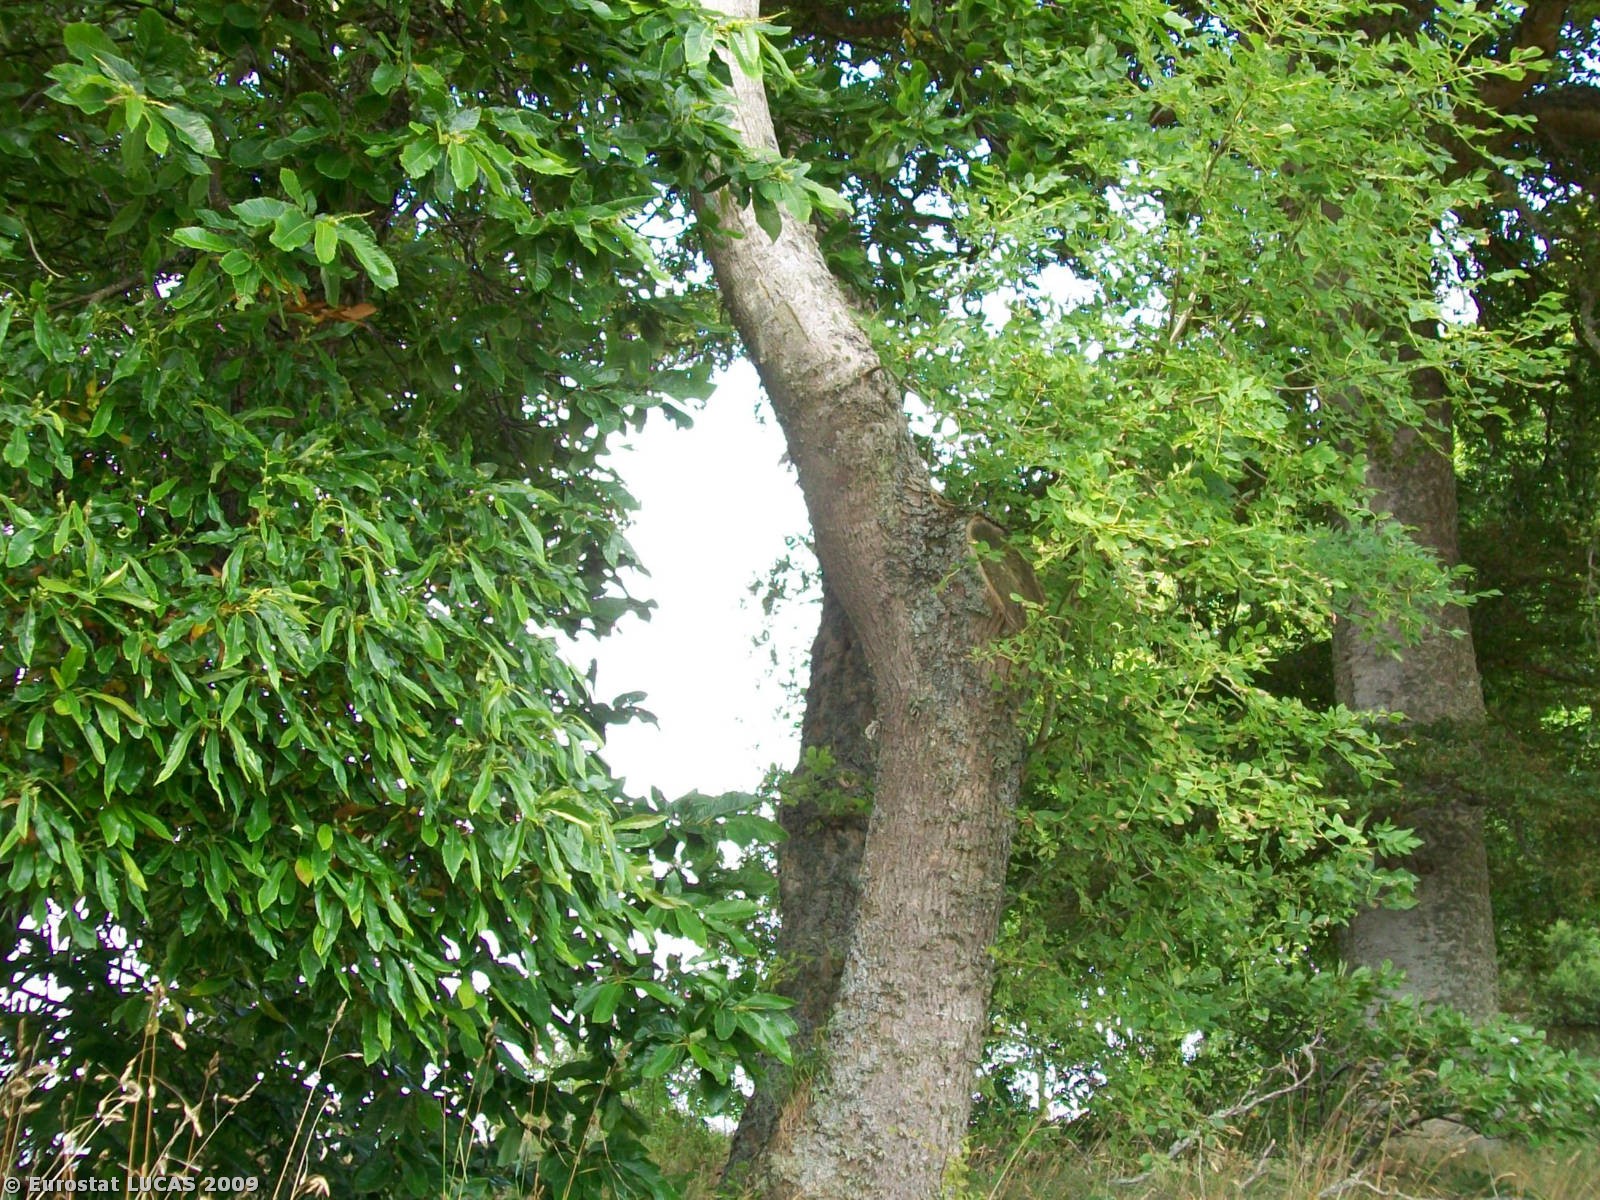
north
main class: Cropland
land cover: Barley
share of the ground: > 75 %
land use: Agriculture (excluding fallow land and kitchen gardens)
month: August
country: GB
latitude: 57.5615
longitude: -4.2771
